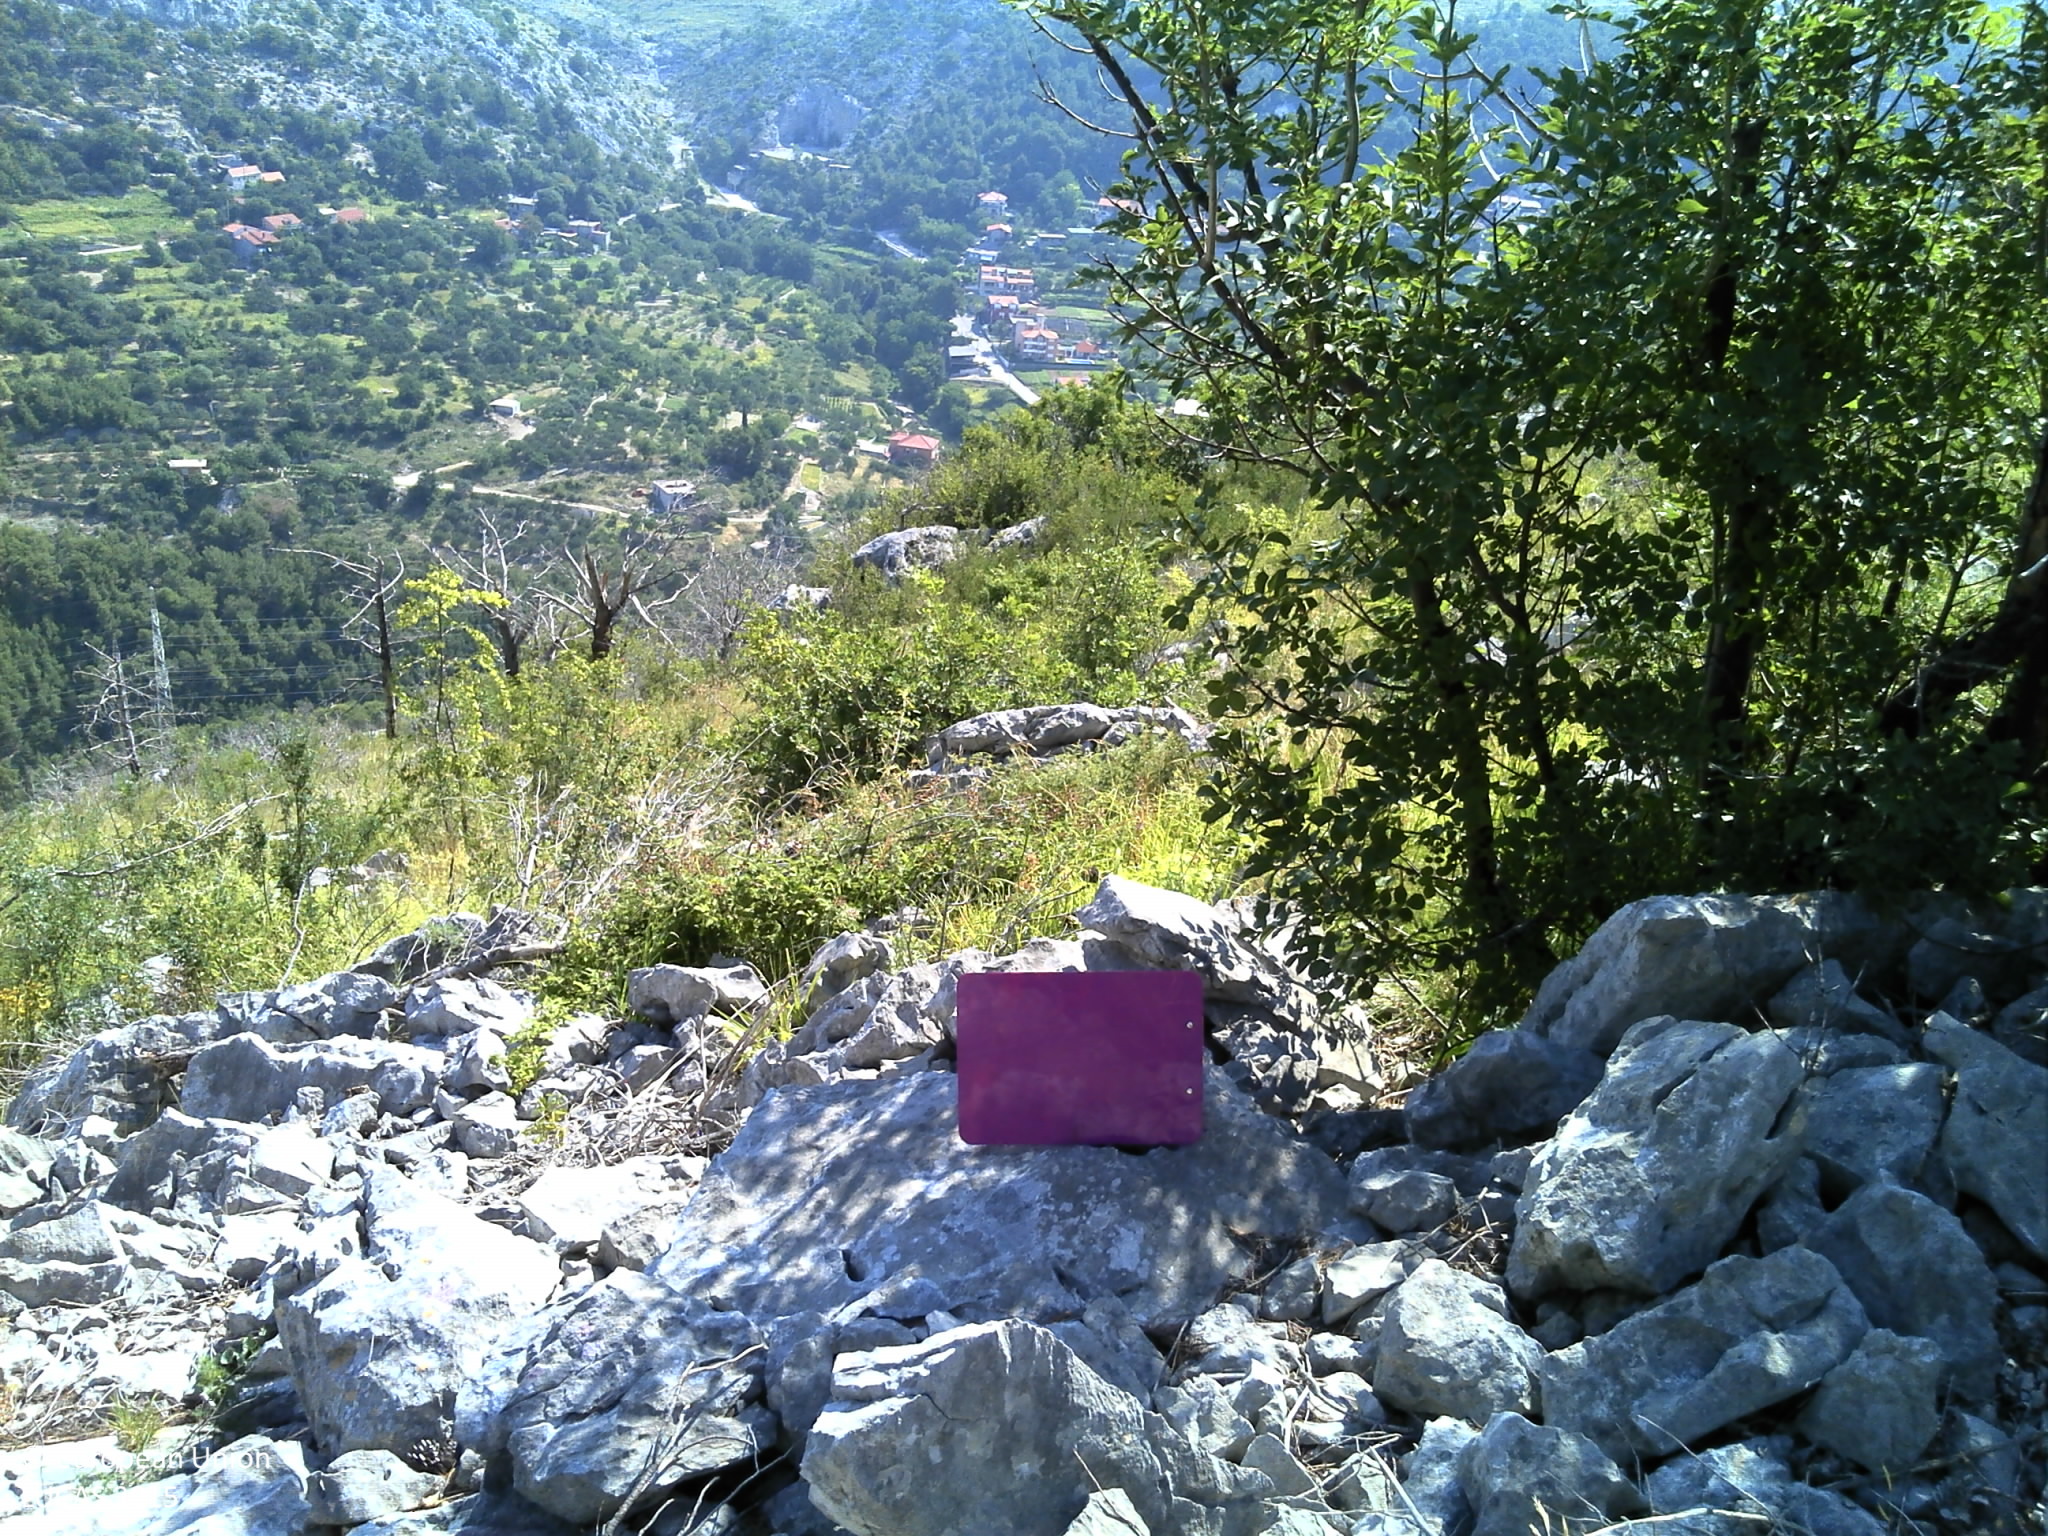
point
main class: Shrubland
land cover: Shrubland with sparse tree cover
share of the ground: 25 - 50 %
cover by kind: shrubs 30 %, herbaceous plants 30 %, unconsolidated bare surface 20 %, consolidated bare surface 10 %, coniferous forest trees 5 %, lichens and mosses 5 %
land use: Semi-natural and natural areas not in use
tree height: < 5 m
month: July
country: HR
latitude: 43.5080
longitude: 16.5837
